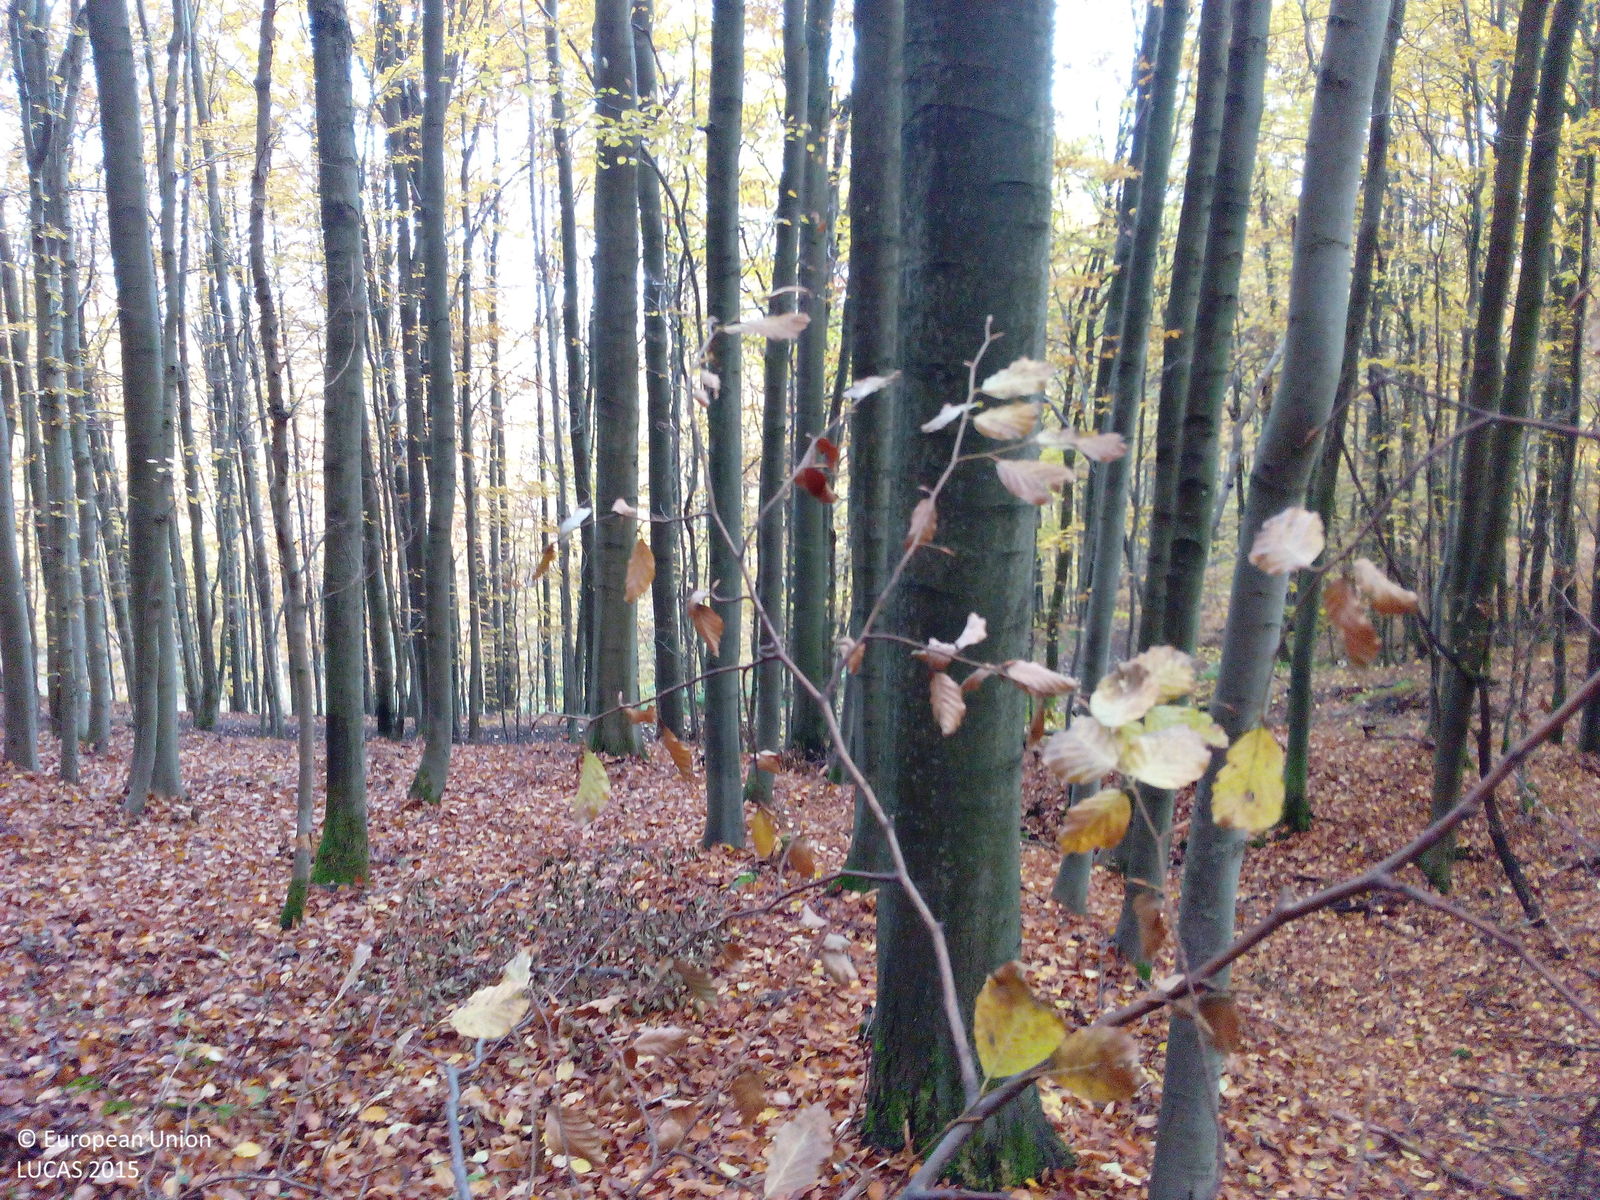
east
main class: Woodland
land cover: Broadleaved woodland
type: mesophytic deciduous forest
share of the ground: > 75 %
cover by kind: broadleaved forest trees 75 %, unconsolidated bare surface 20 %, herbaceous plants 5 %
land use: Forestry
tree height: > 5 m
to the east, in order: Broadleaved woodland; Ditches and canals; Tracks; Broadleaved woodland; Ditches and canals; Tracks; Broadleaved woodland; Tracks; Broadleaved woodland
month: October
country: DE
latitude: 50.3101
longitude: 9.9298
